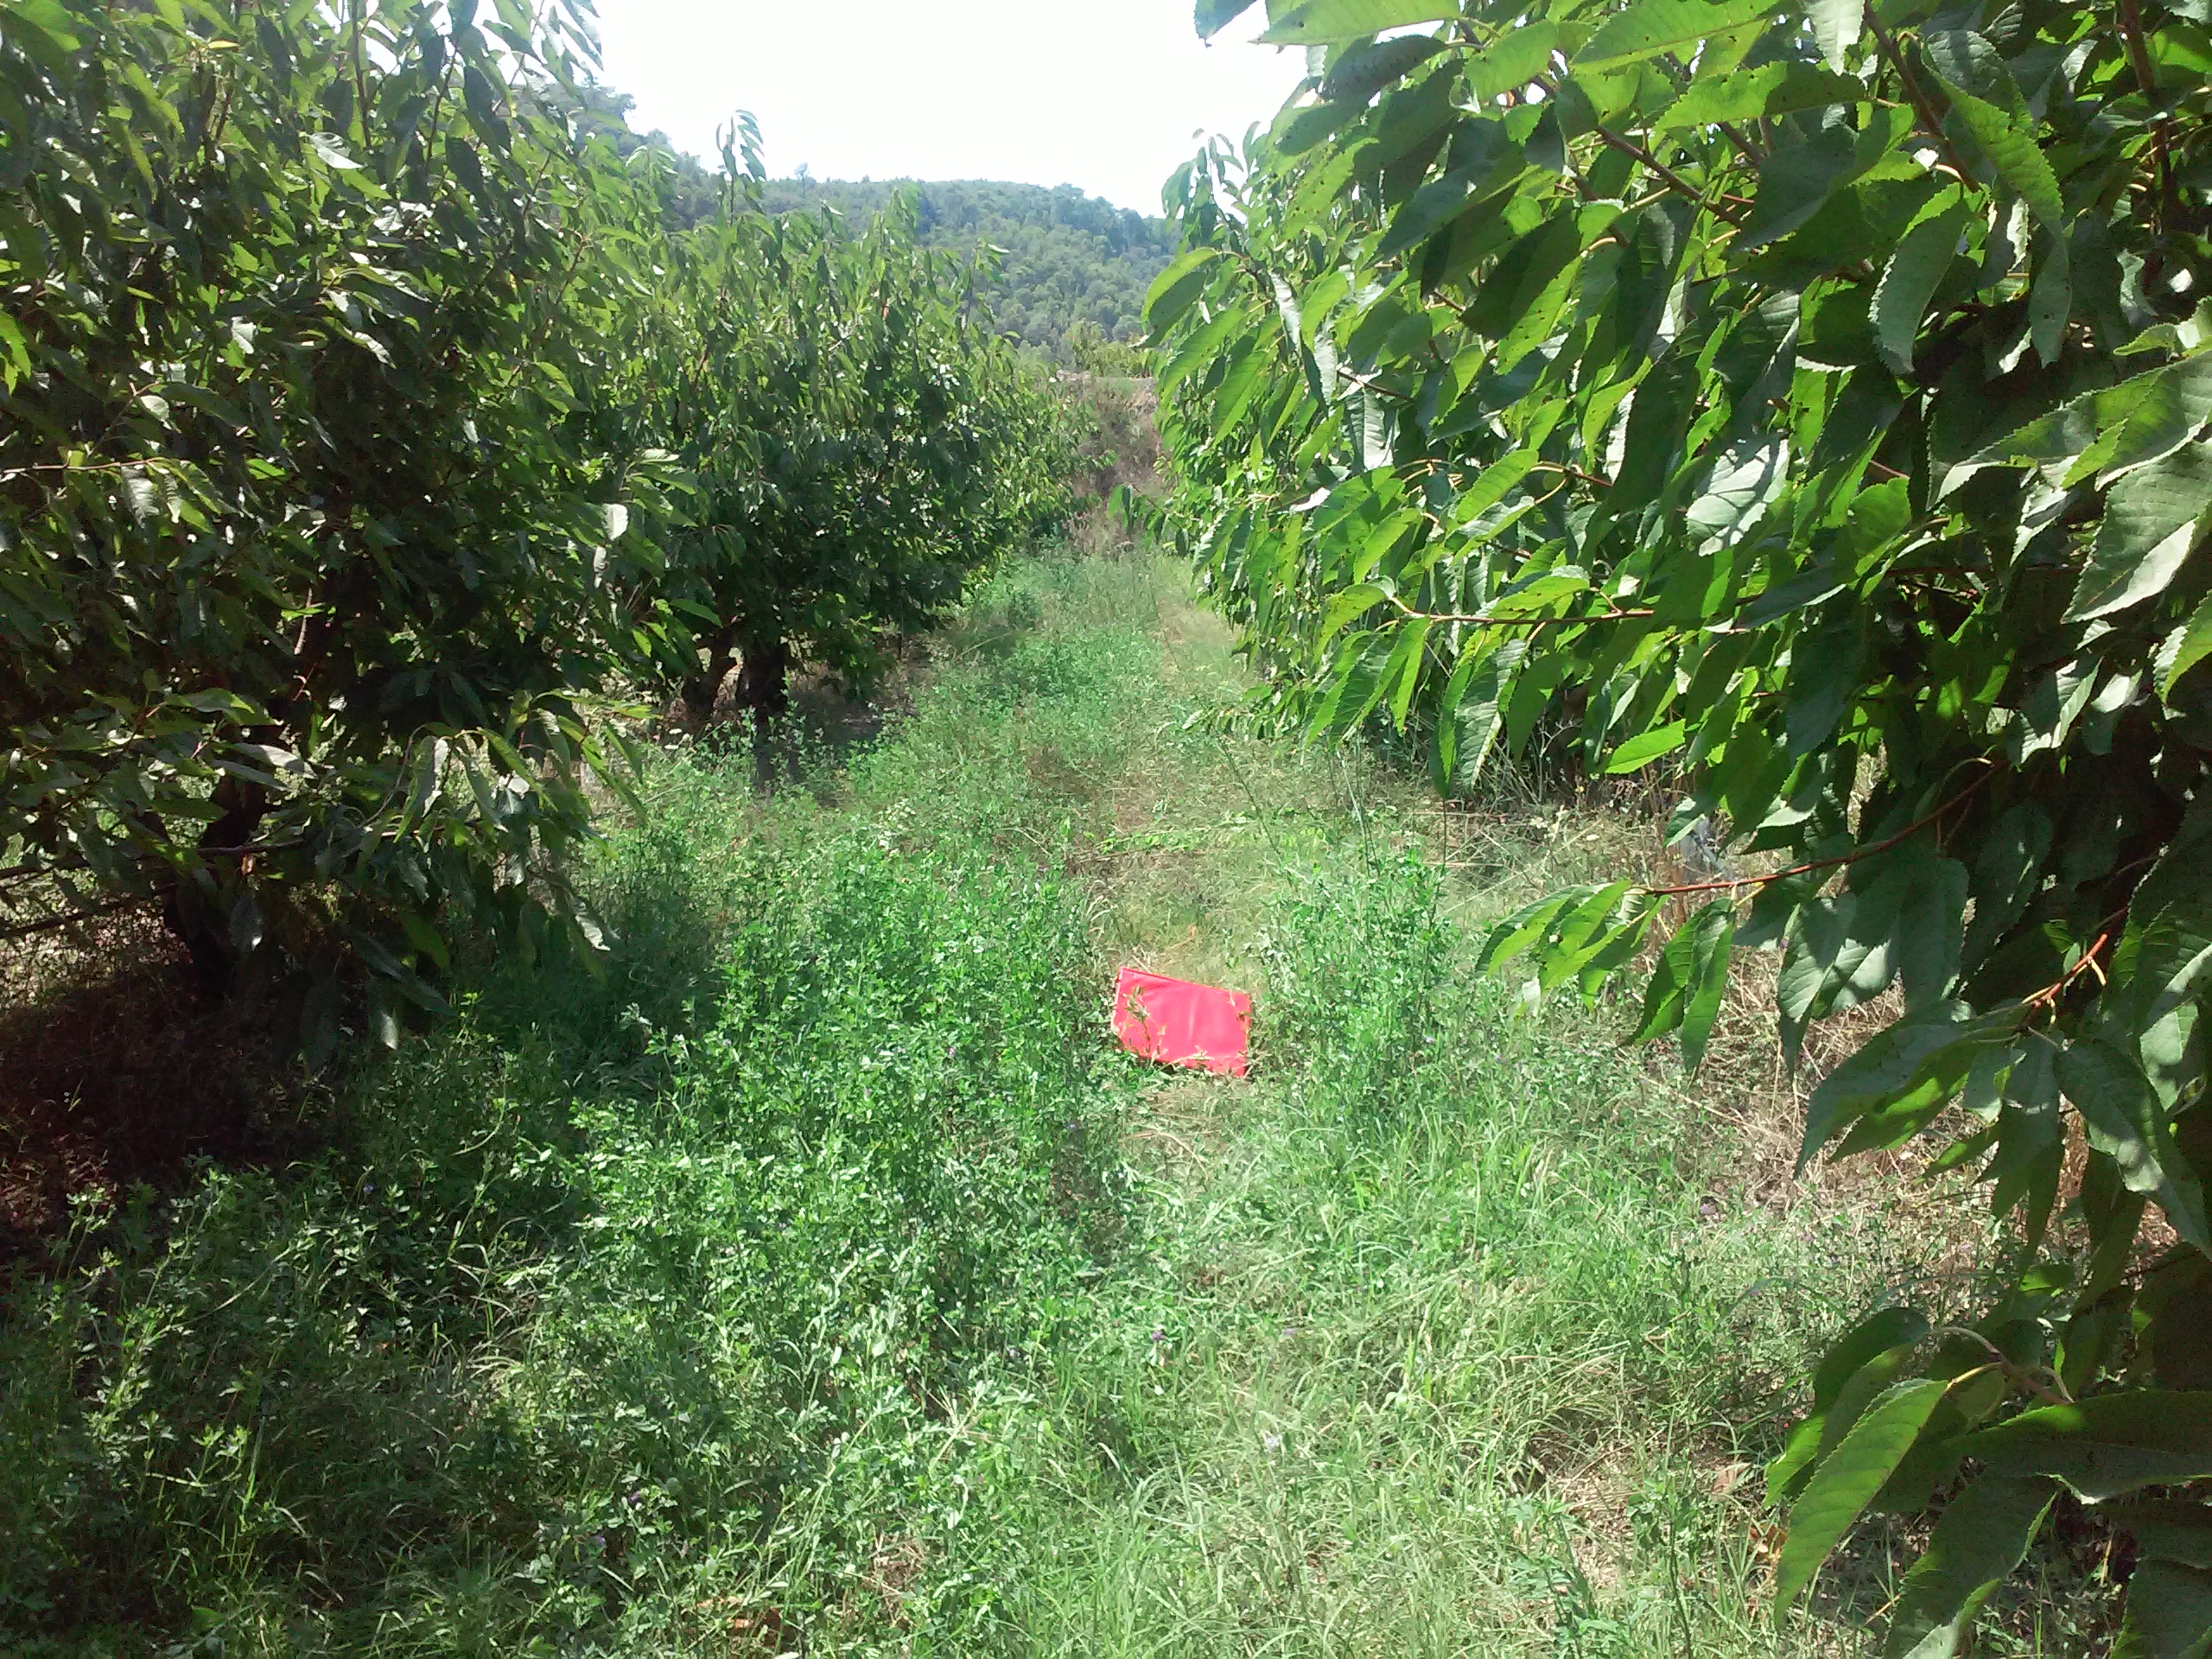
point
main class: Cropland
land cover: Cherry fruit
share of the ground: 25 - 50 %
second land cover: Other bare soil
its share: > 75 %
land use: Agriculture (excluding fallow land and kitchen gardens)
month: August
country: ES
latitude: 41.0507
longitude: 0.5811
